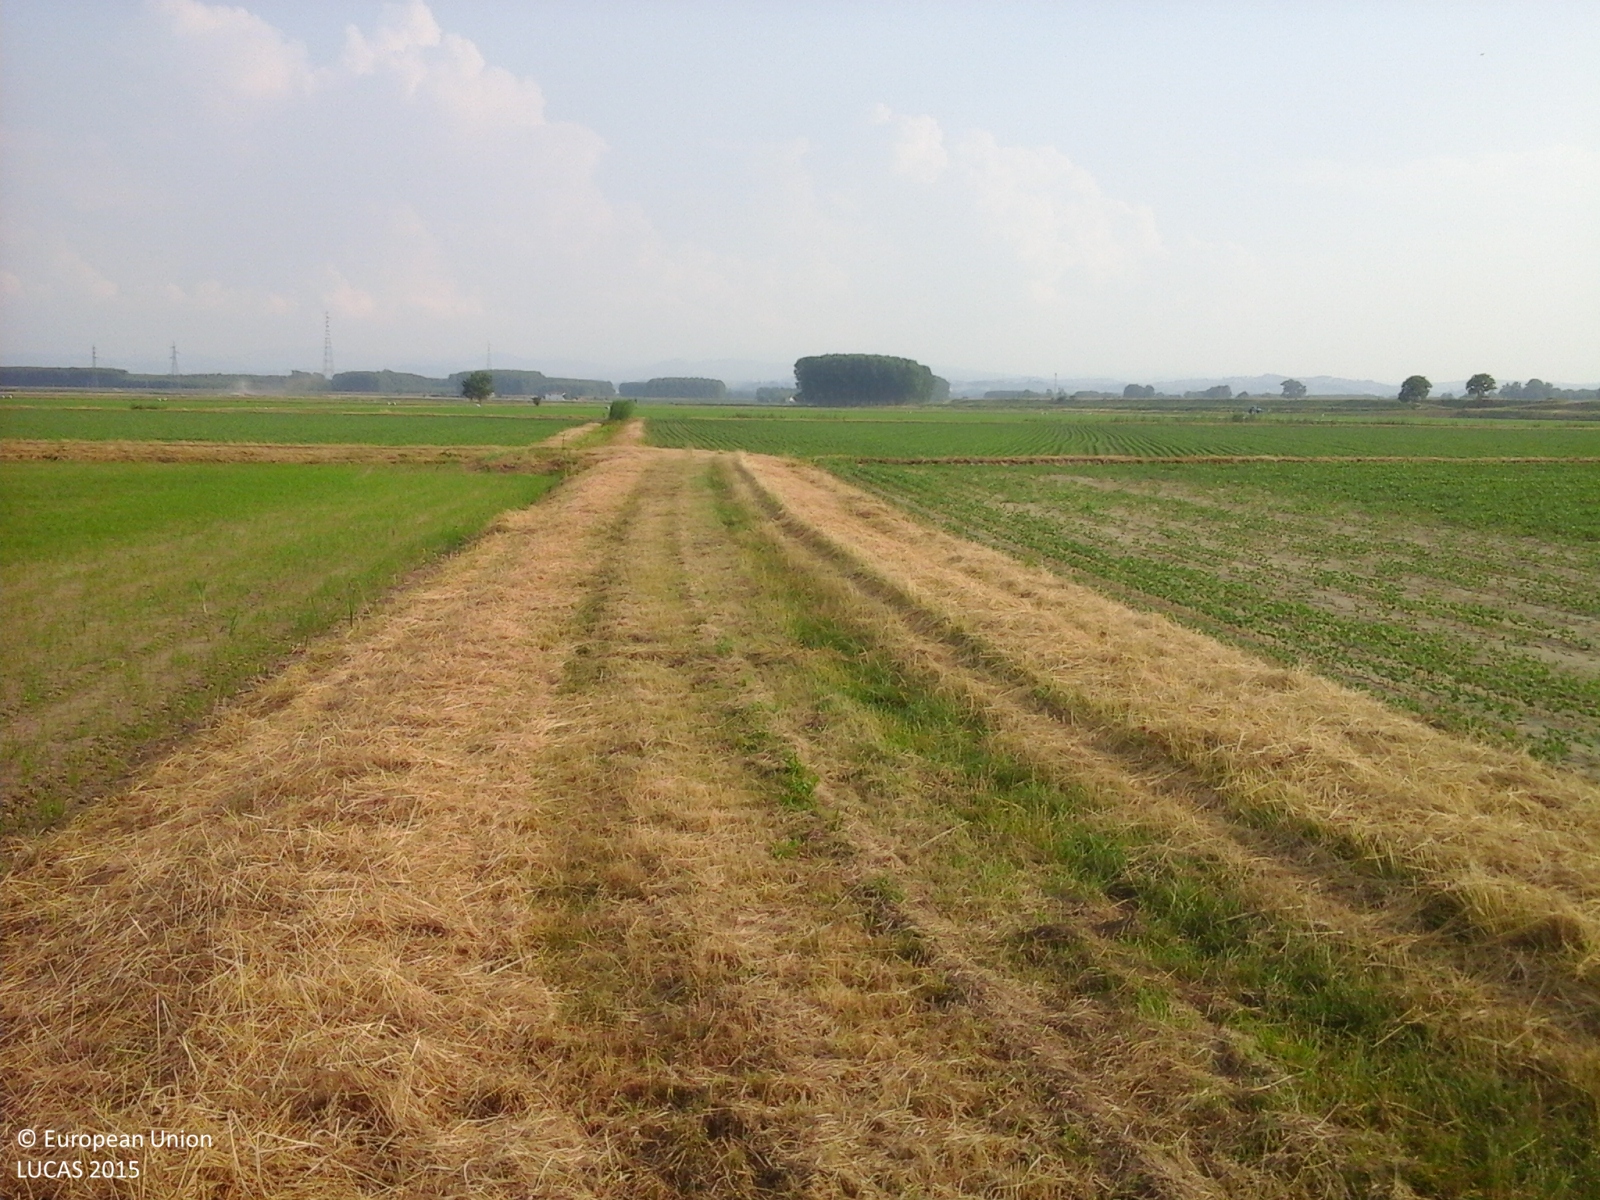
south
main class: Cropland
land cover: Rice
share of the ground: 50 - 75 %
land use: Agriculture (excluding fallow land and kitchen gardens)
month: June
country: IT
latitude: 45.1240
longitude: 9.3782
